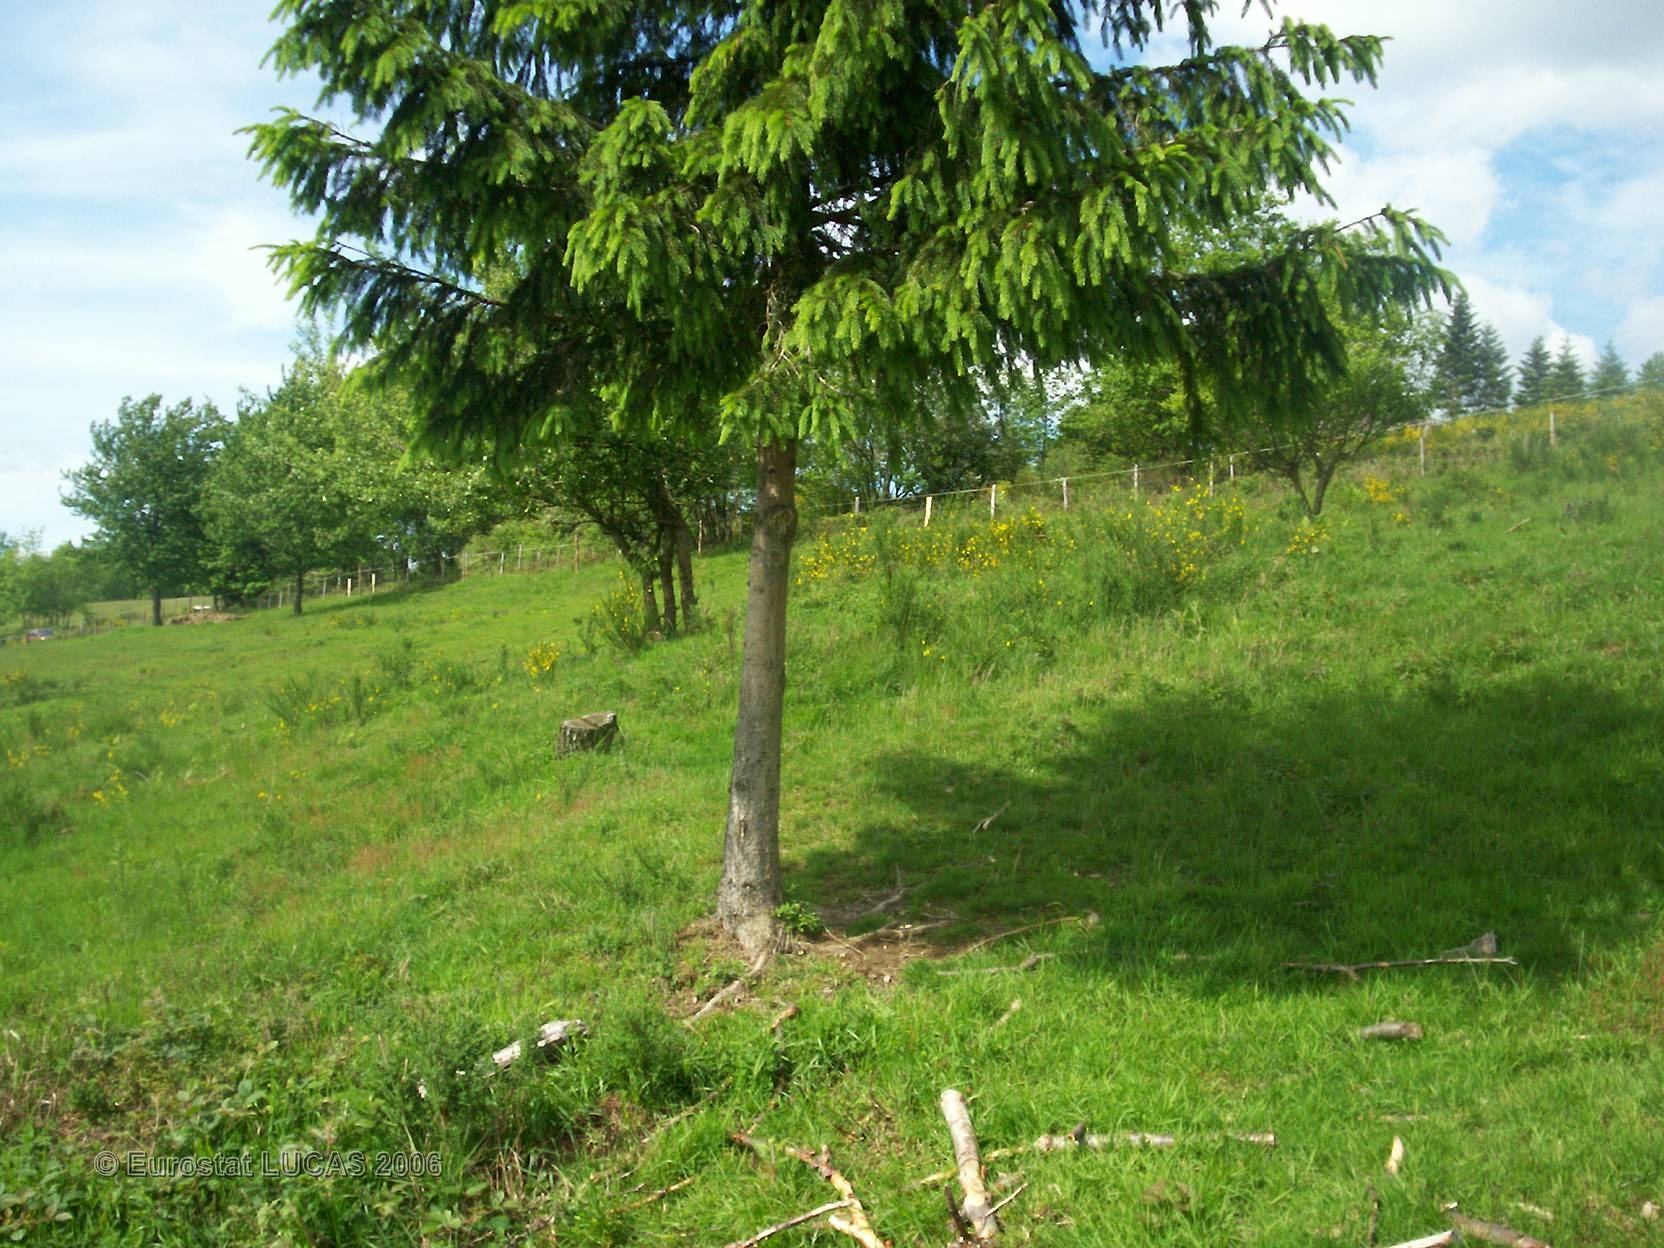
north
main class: Grassland
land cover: Grassland with sparse tree/shrub cover
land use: Agriculture (excluding fallow land and kitchen gardens)
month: June
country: FR
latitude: 48.2209
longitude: 7.0802
